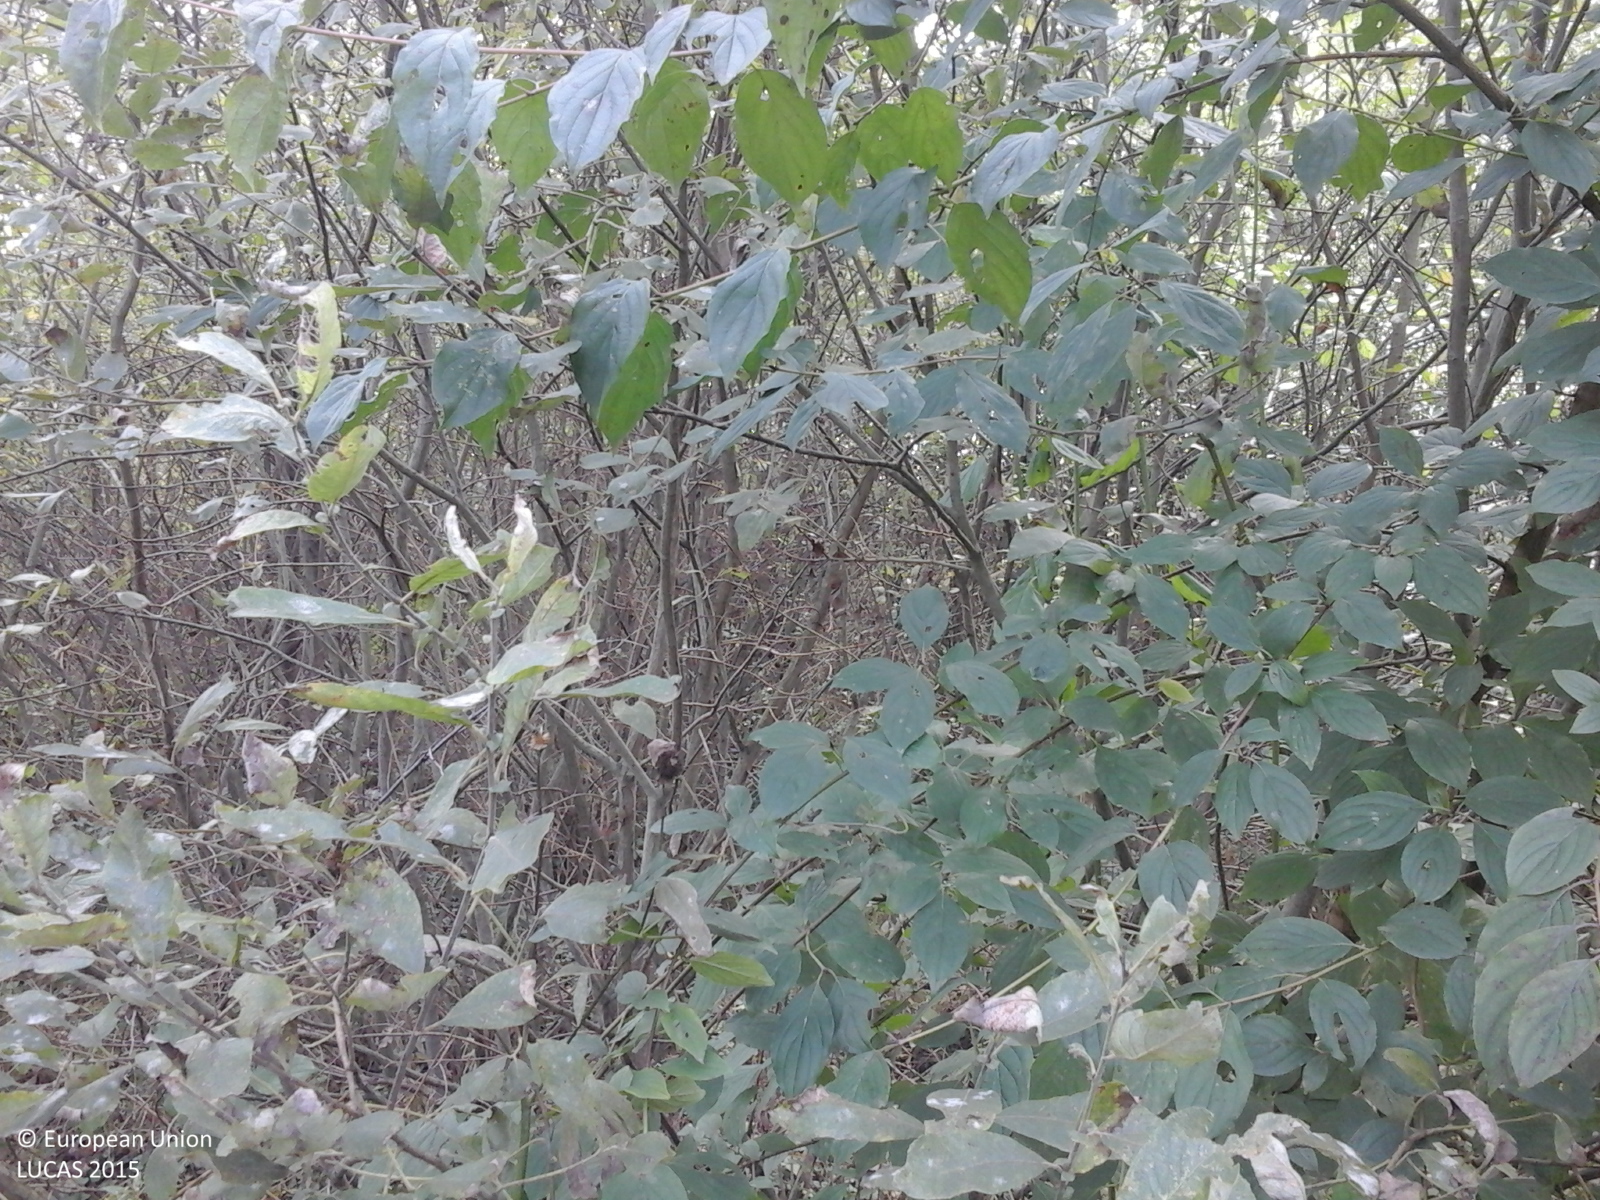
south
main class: Woodland
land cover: Broadleaved woodland
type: non-riverine alder, birch or aspen forest
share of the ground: > 75 %
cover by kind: broadleaved forest trees 100 %
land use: Semi-natural and natural areas not in use
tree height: < 5 m
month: September
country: RO
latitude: 45.5086
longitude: 22.1619
